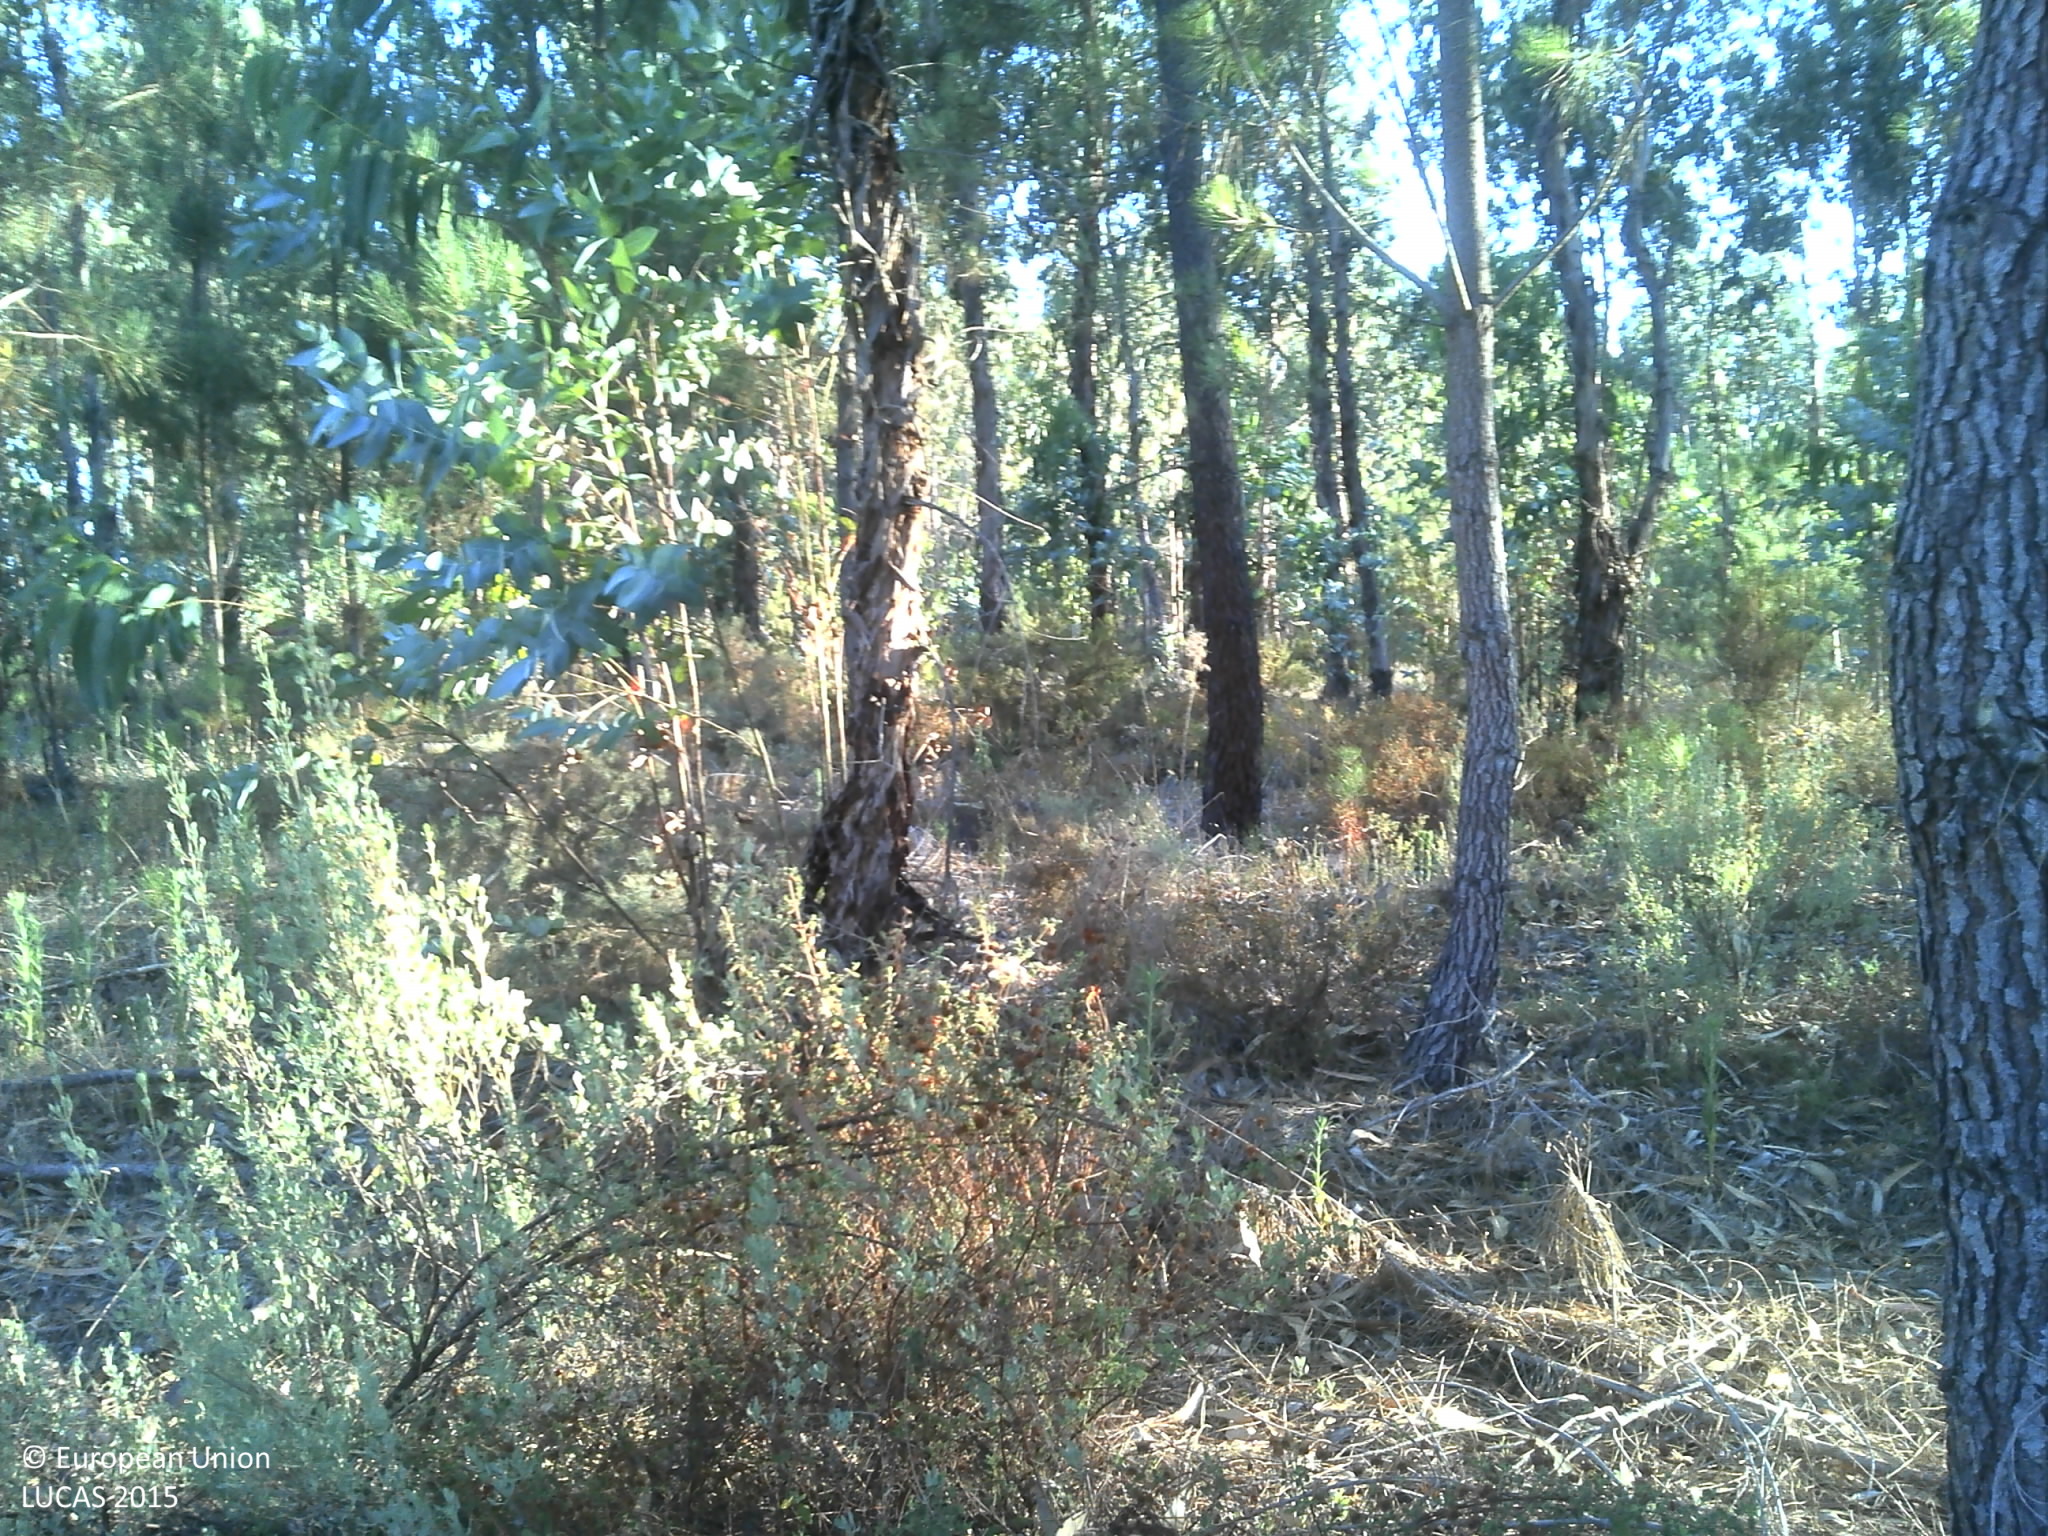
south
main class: Woodland
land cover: Pine dominated mixed woodland
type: coniferous forest of the mediterranean region
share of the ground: 25 - 50 %
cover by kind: coniferous forest trees 45 %, broadleaved forest trees 30 %, herbaceous plants 10 %, unconsolidated bare surface 10 %, shrubs 5 %
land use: Forestry
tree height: > 5 m
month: July
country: PT
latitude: 39.0075
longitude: -8.6952
